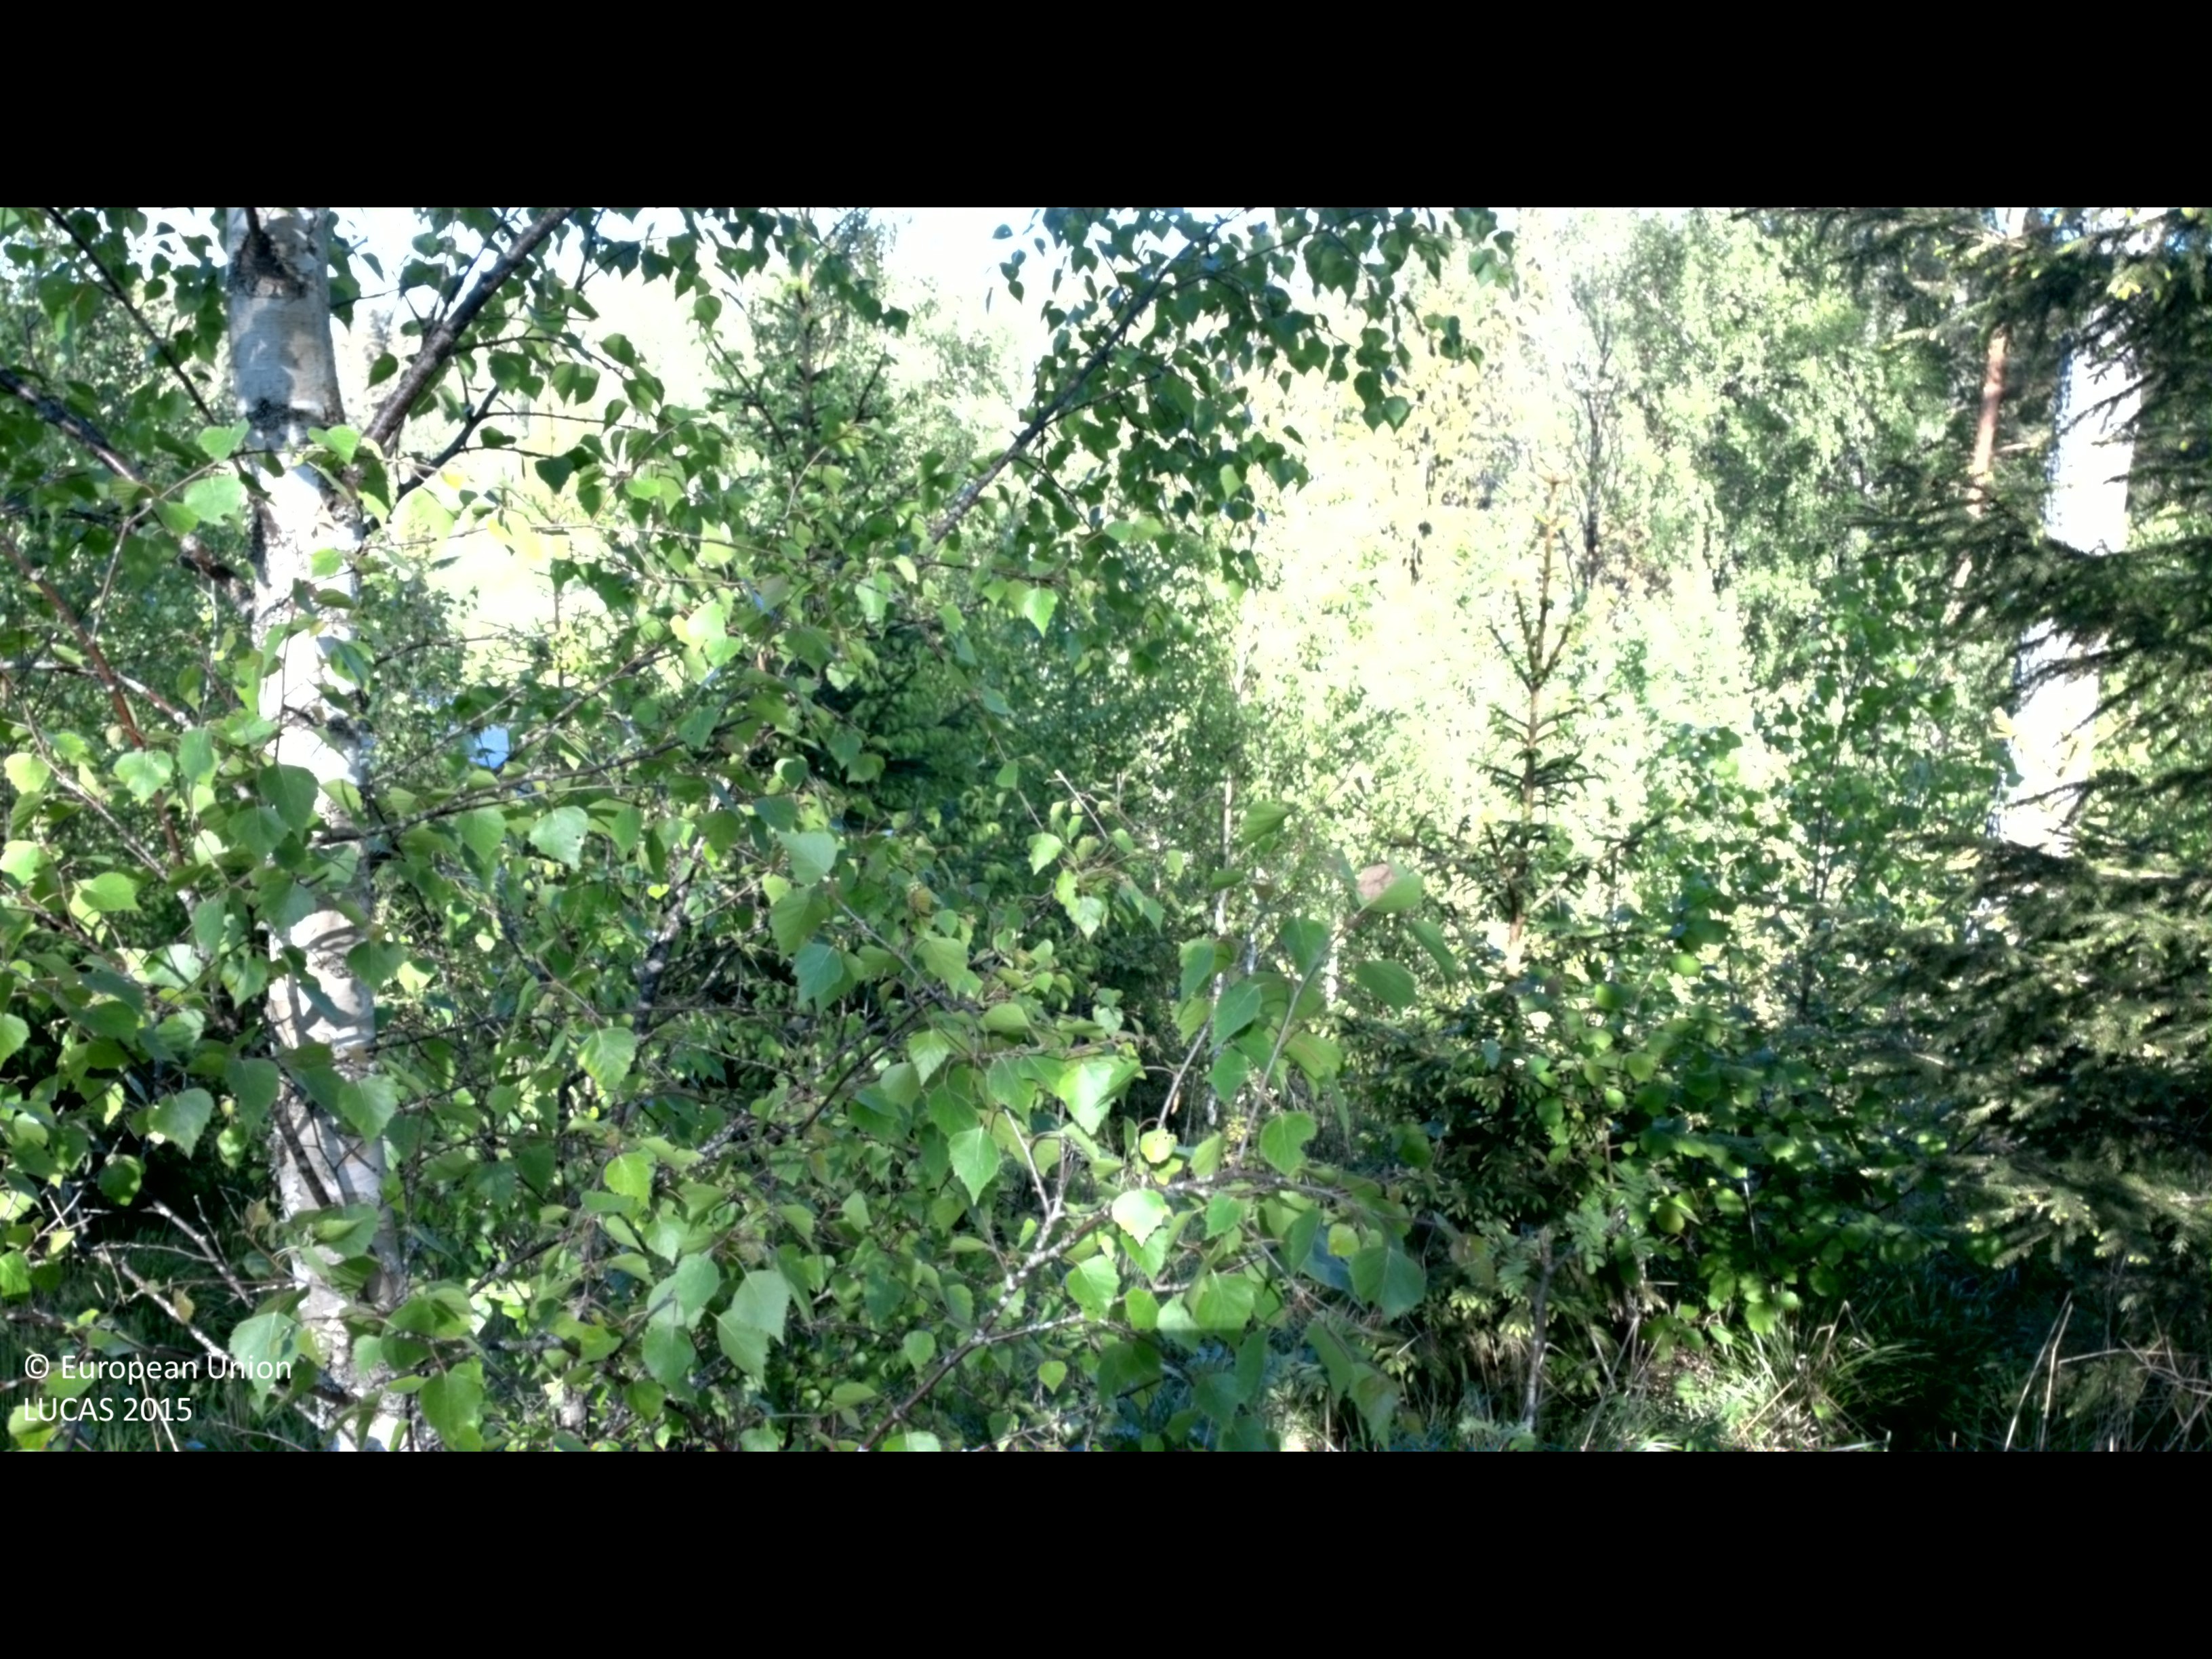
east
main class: Woodland
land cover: Spruce dominated mixed woodland
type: hemiboreal forest and nemoral coniferous forest and mixed broadleaved-coniferous forest
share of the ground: 25 - 50 %
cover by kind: herbaceous plants 40 %, shrubs 25 %, coniferous forest trees 20 %, broadleaved forest trees 15 %
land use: Forestry
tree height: > 5 m
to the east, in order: Spruce dominated mixed woodland; Broadleaved woodland; Inland fresh water bodies; Grassland with sparse tree/shrub cover; Grassland without tree/shrub cover; Fences; Pine dominated mixed woodland; Pine dominated coniferous woodland
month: June
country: SE
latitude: 57.8413
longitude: 16.2131
